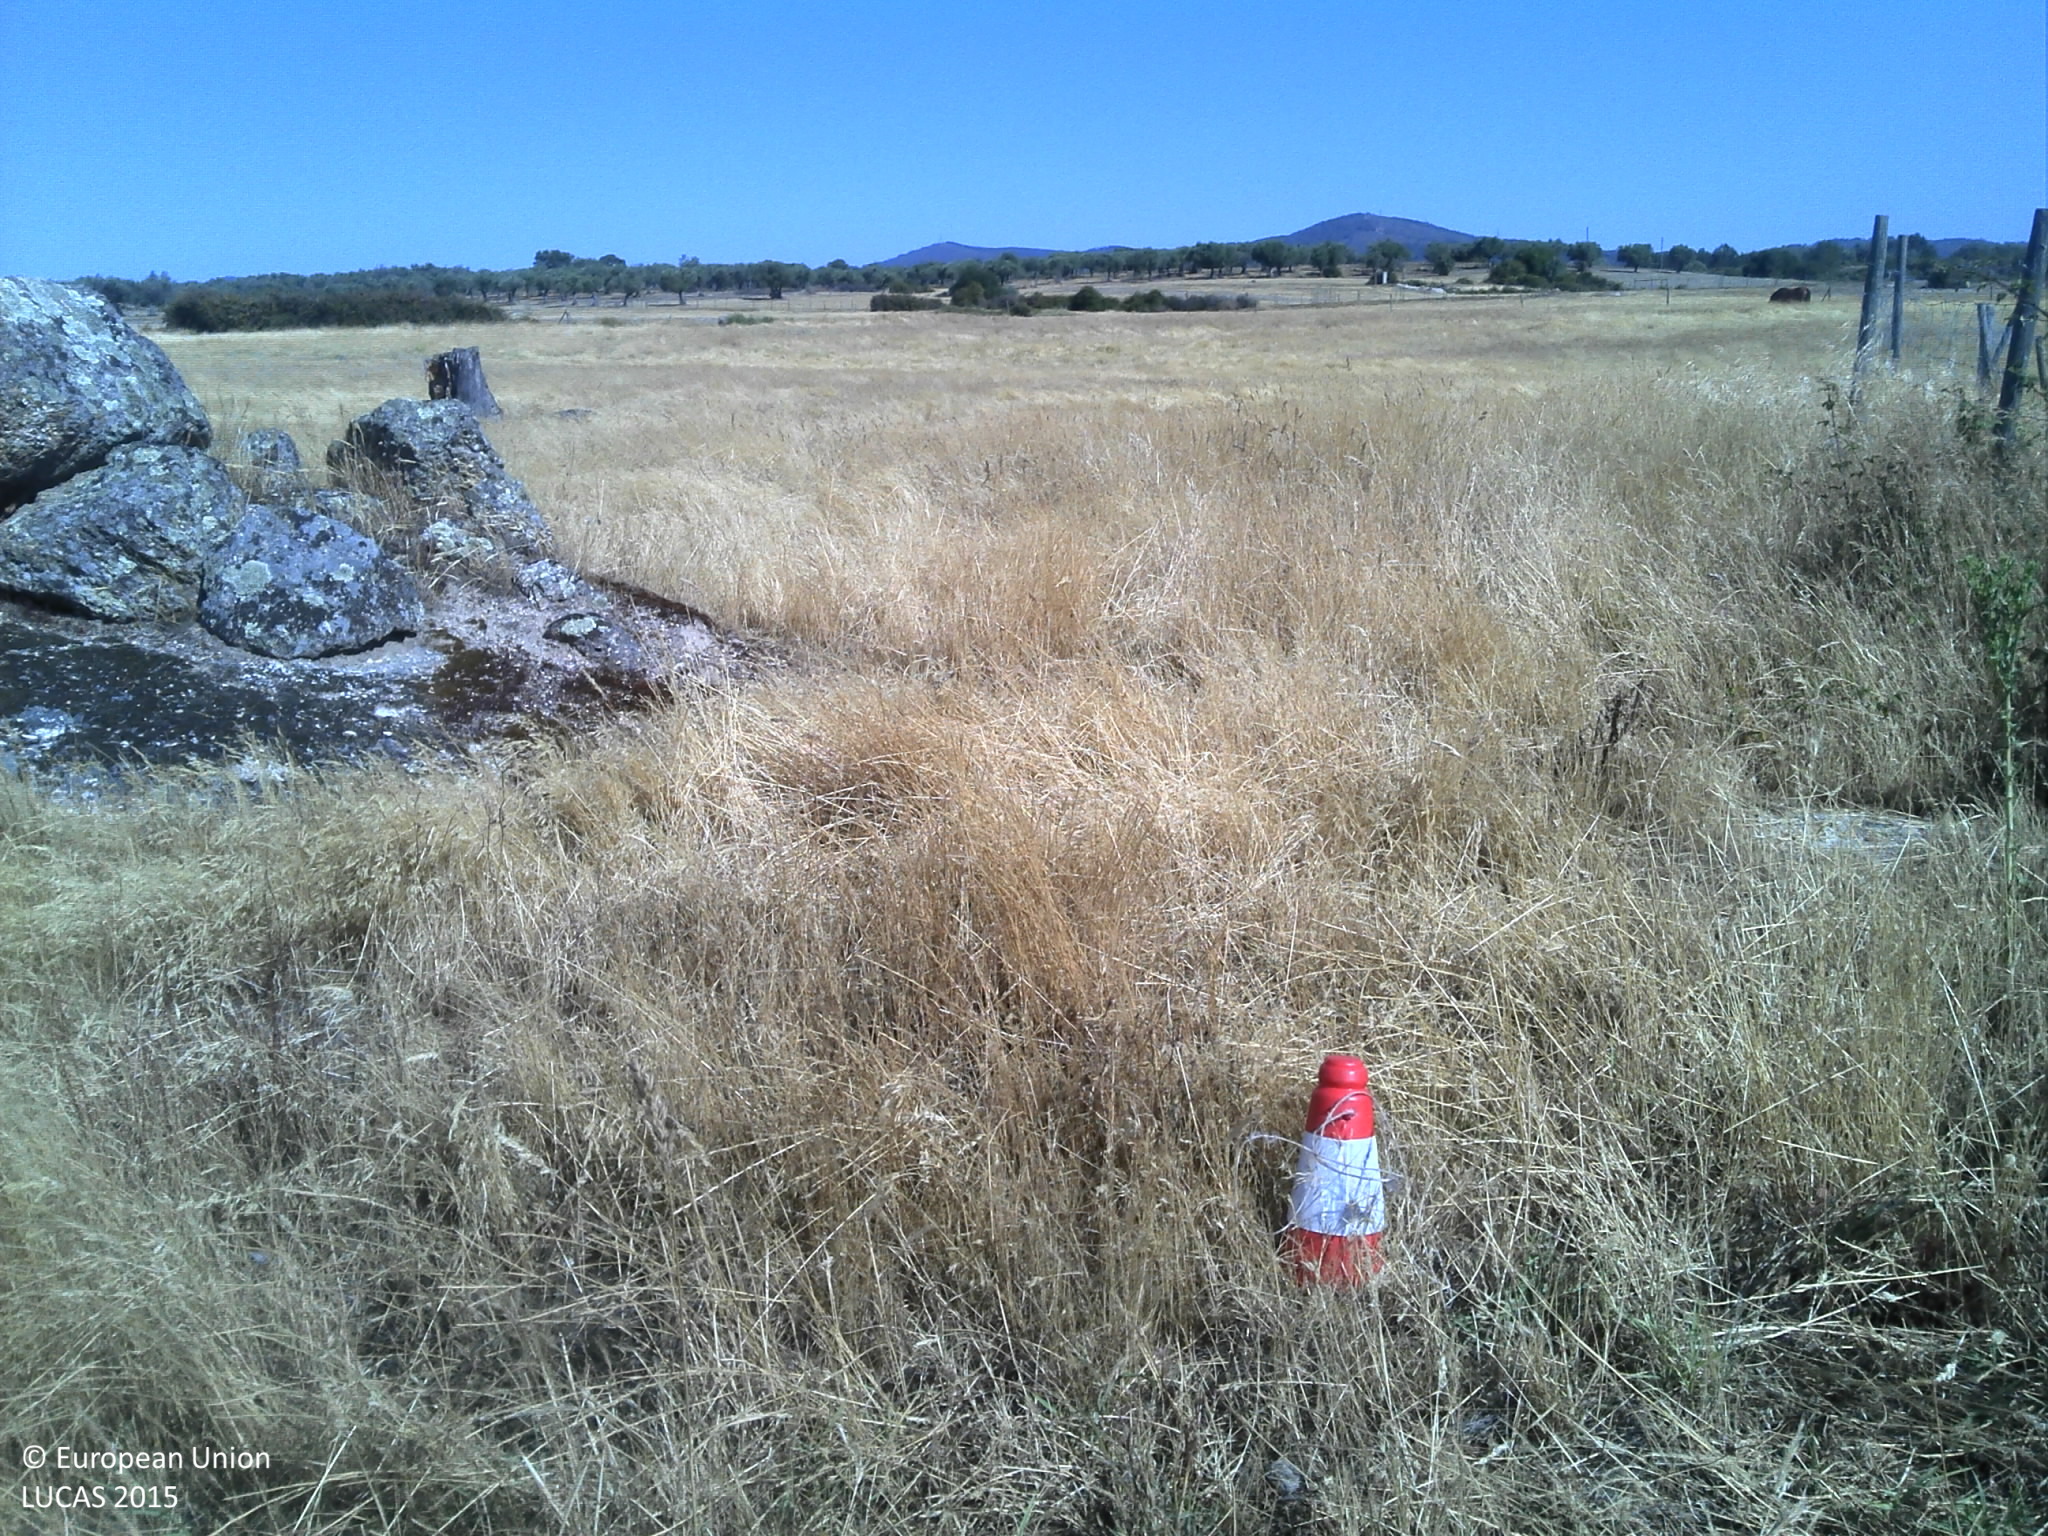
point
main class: Grassland
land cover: Grassland without tree/shrub cover
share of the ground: 50 - 75 %
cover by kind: herbaceous plants 60 %, unconsolidated bare surface 35 %
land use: Agriculture (excluding fallow land and kitchen gardens)
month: June
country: PT
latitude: 40.0739
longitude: -7.3488
